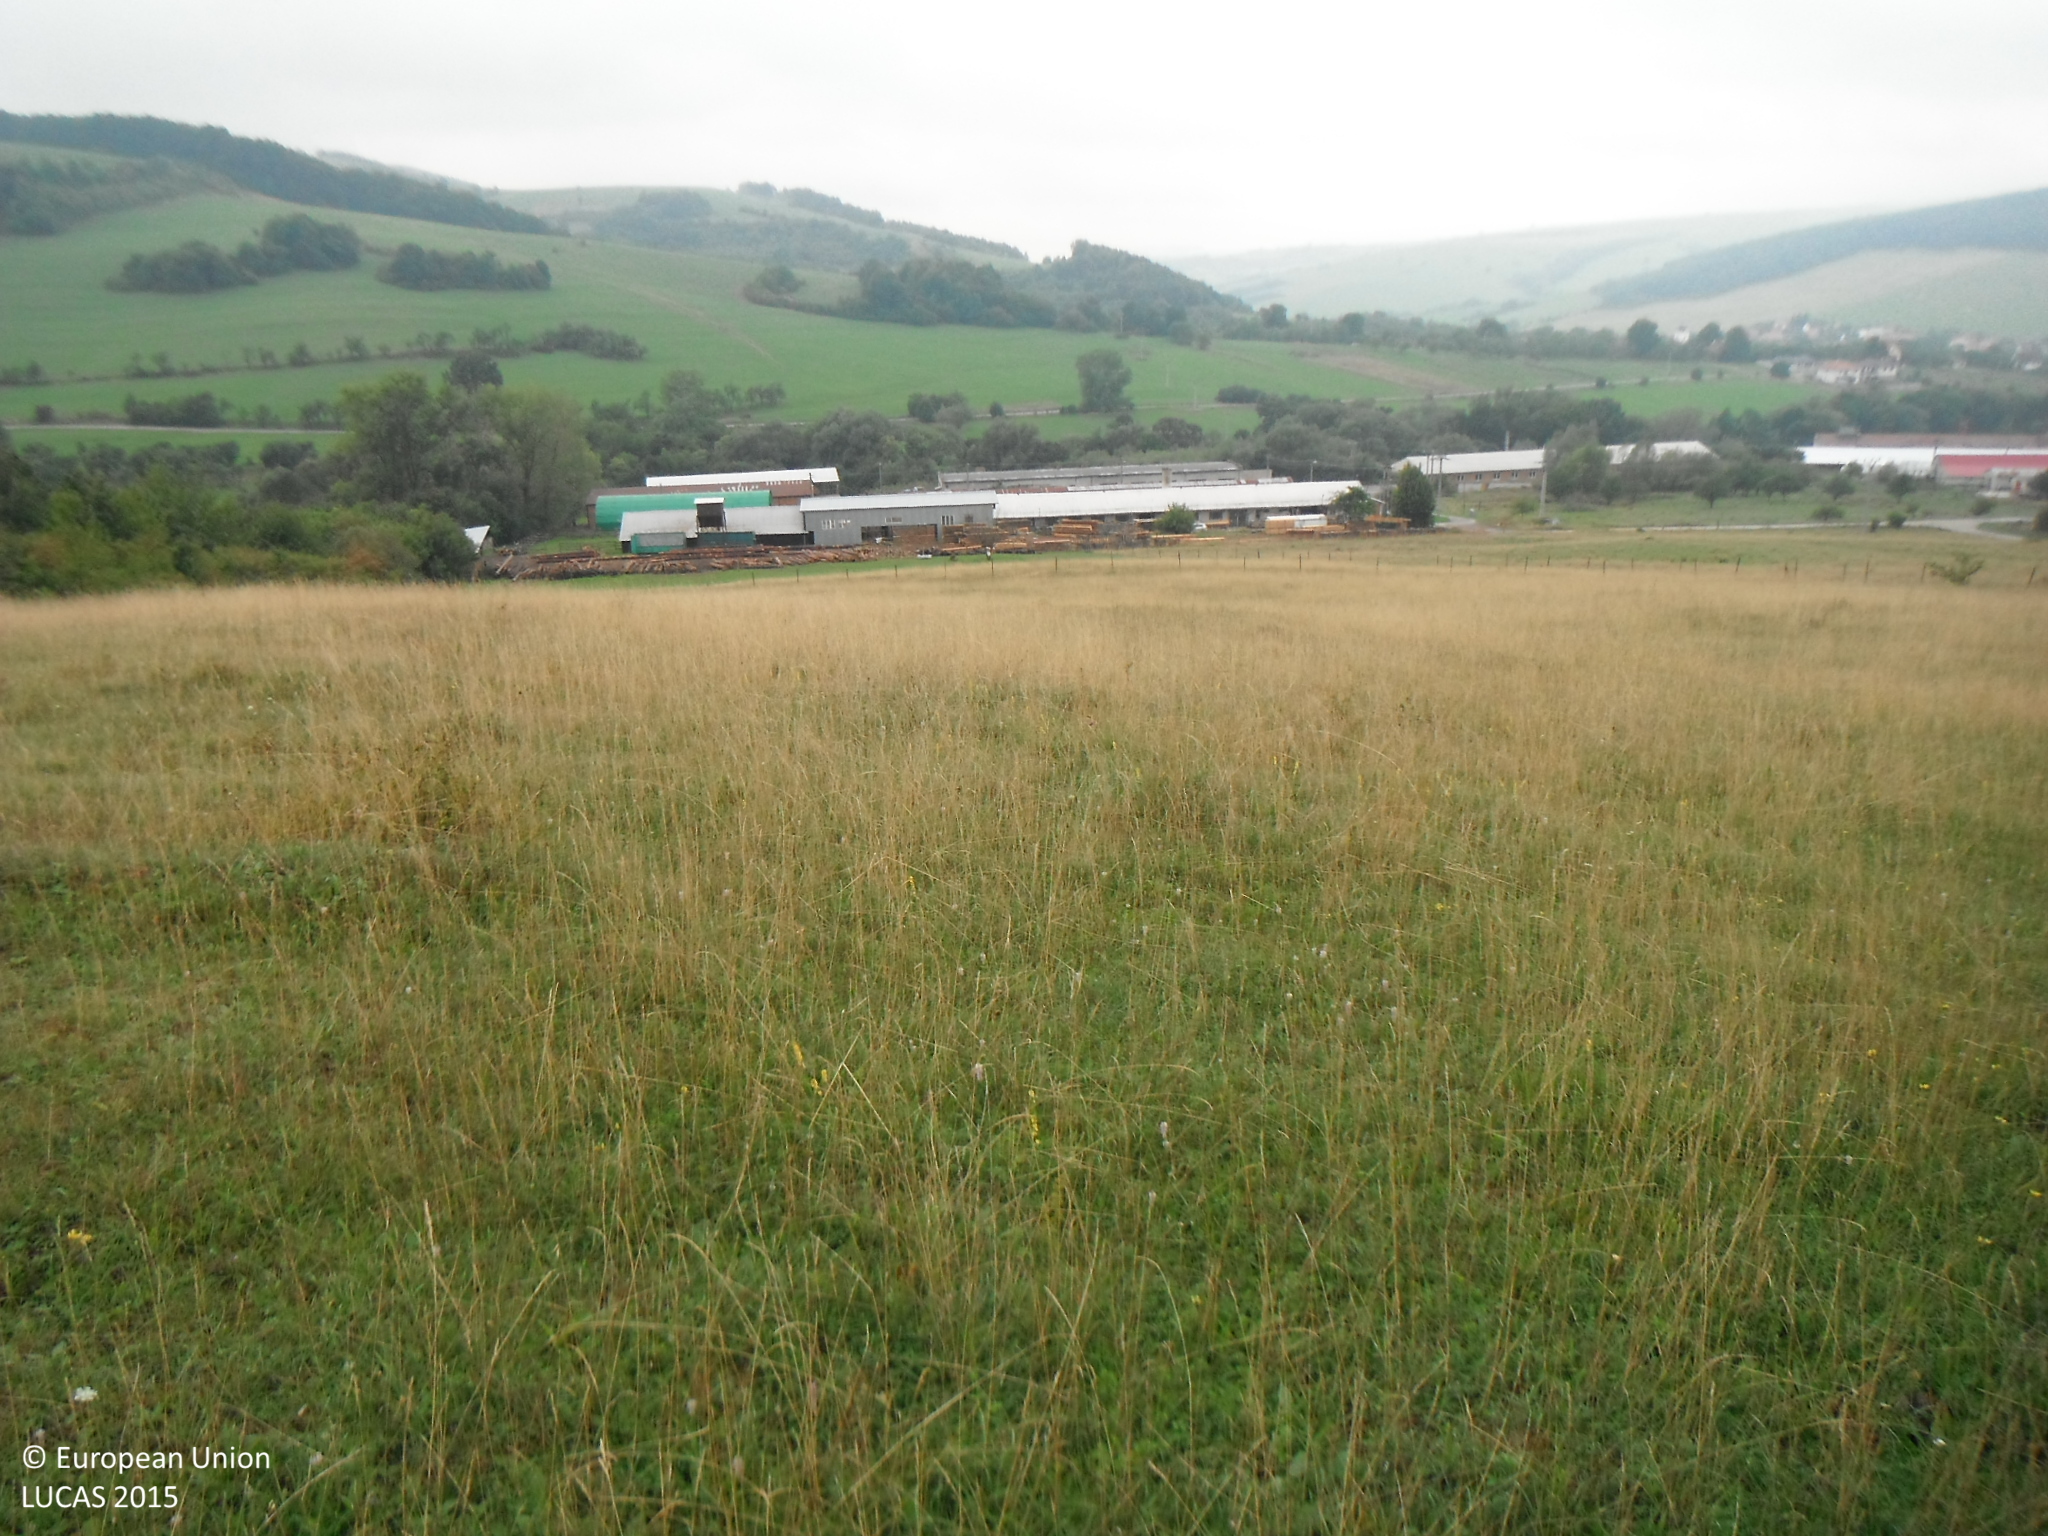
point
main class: Grassland
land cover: Grassland without tree/shrub cover
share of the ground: > 75 %
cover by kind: herbaceous plants 95 %, shrubs 5 %
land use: Agriculture (excluding fallow land and kitchen gardens)
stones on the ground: < 10 %
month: September
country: SK
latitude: 48.8000
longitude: 17.4853
